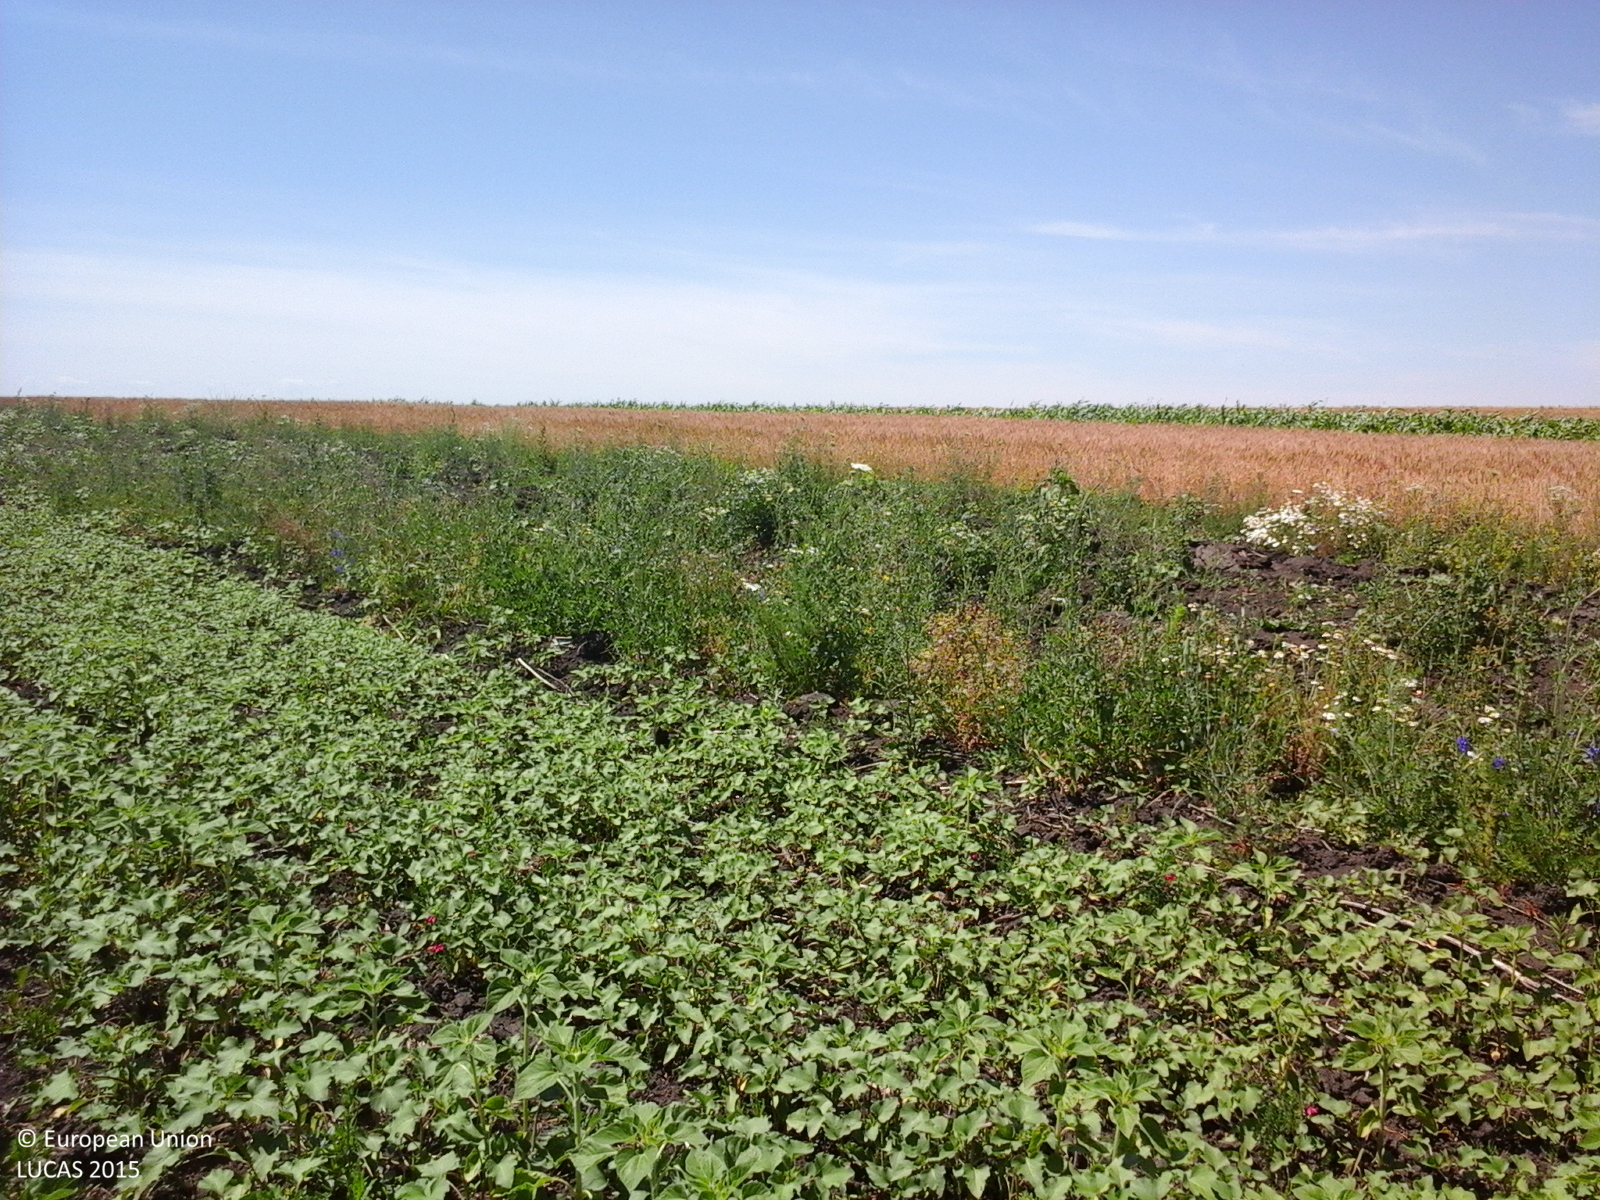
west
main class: Cropland
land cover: Sunflower
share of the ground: > 75 %
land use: Agriculture (excluding fallow land and kitchen gardens)
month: June
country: RO
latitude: 47.2522
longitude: 26.9196
